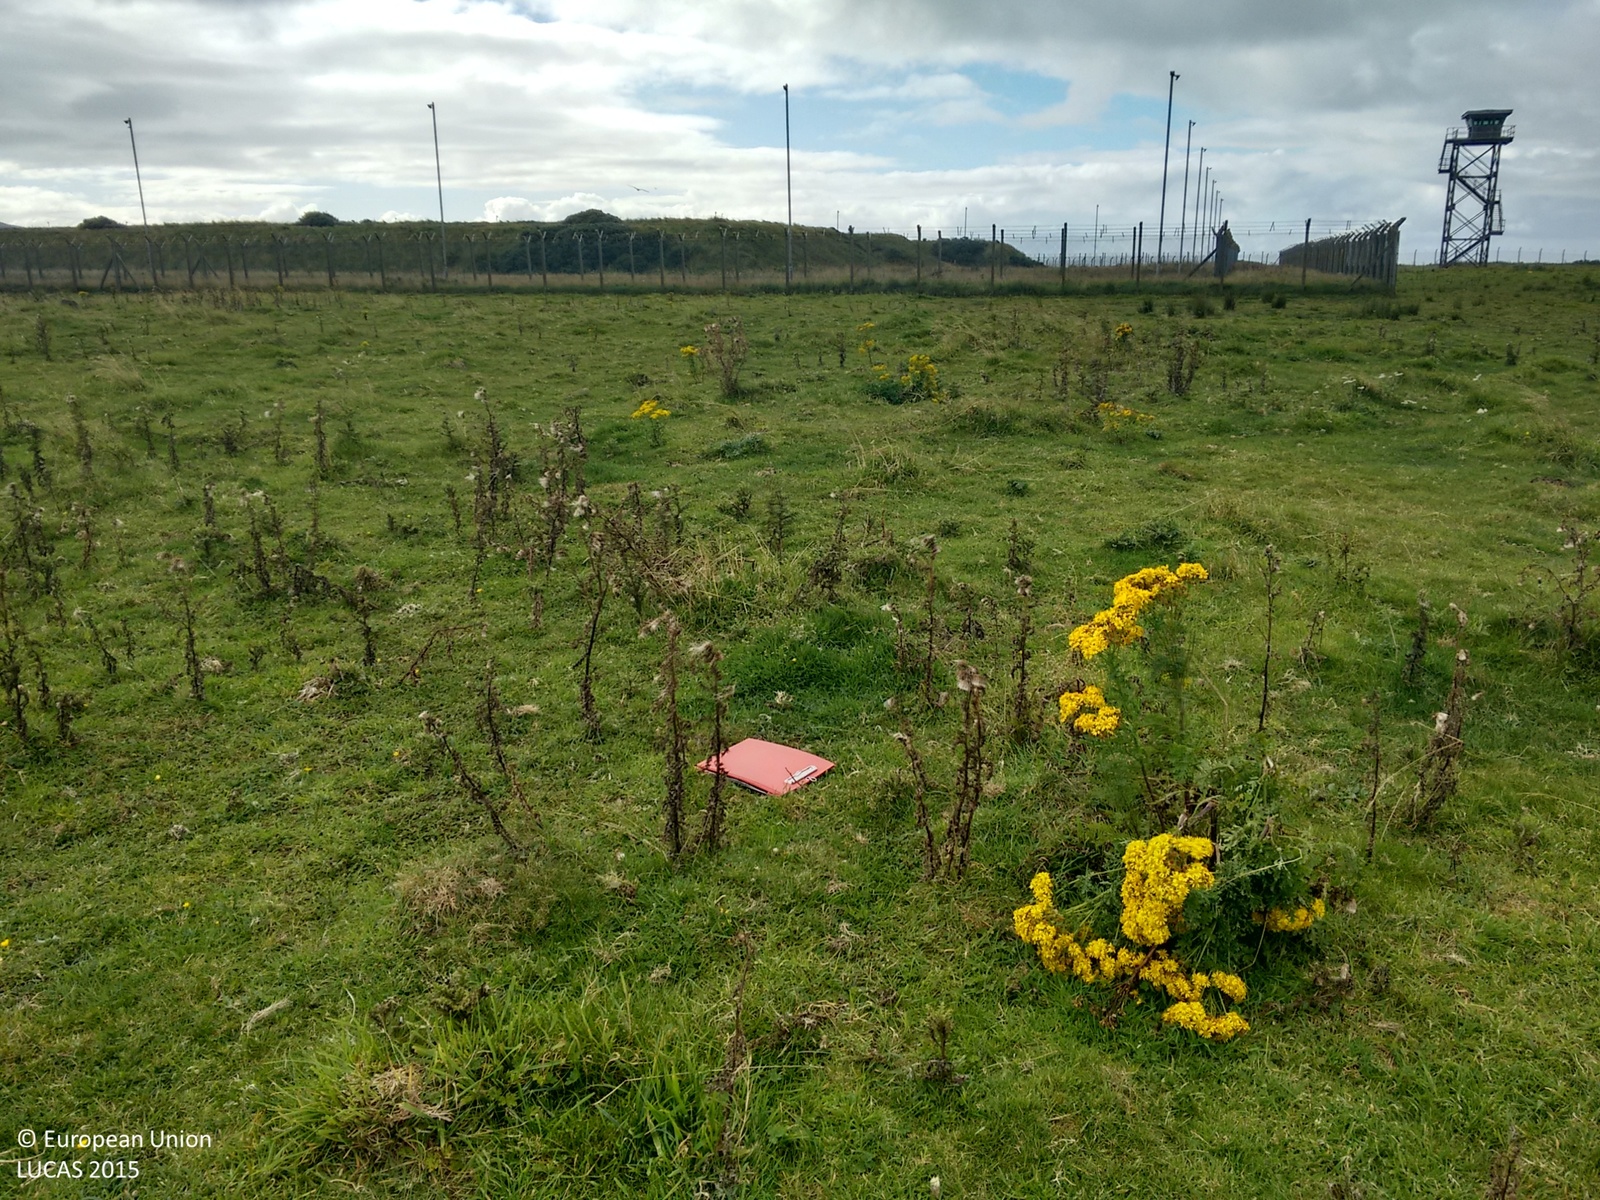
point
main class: Grassland
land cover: Grassland without tree/shrub cover
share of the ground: > 75 %
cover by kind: herbaceous plants 100 %
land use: Semi-natural and natural areas not in use
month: September
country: GB
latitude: 55.4505
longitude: -5.7036
